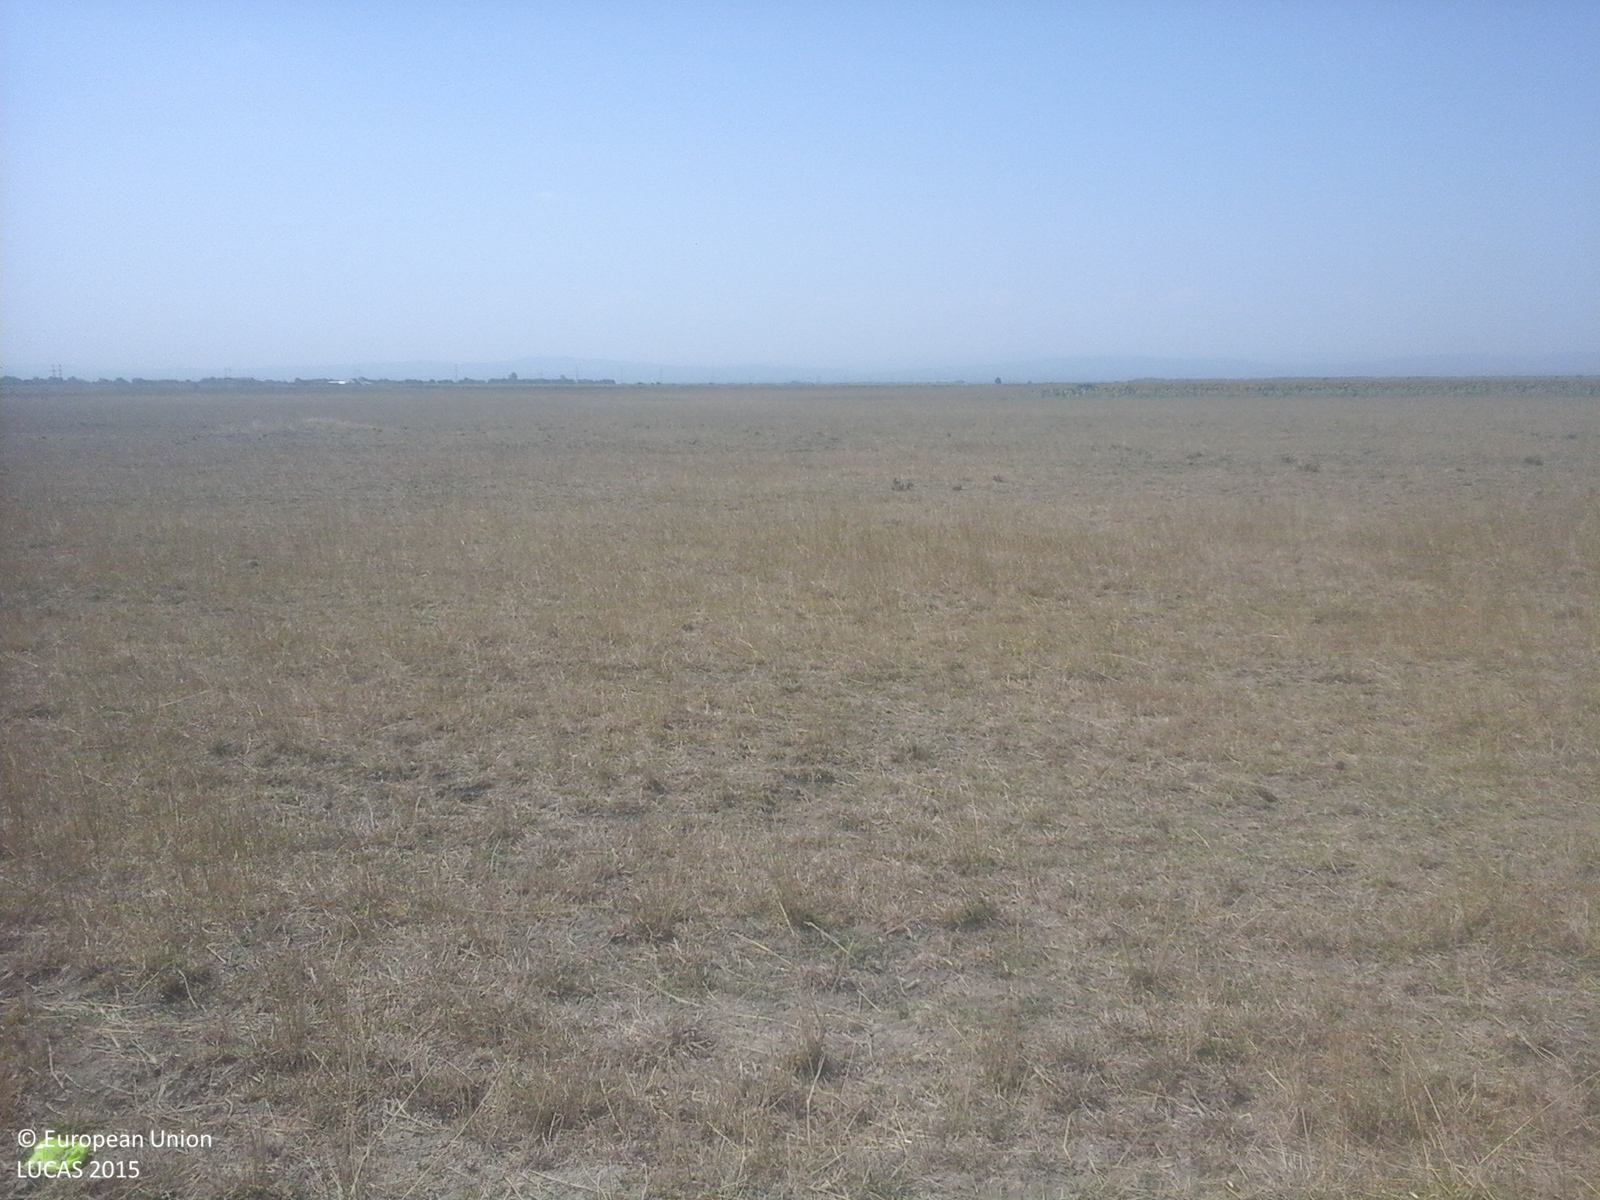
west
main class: Grassland
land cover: Grassland without tree/shrub cover
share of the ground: > 75 %
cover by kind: herbaceous plants 100 %
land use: Agriculture (excluding fallow land and kitchen gardens)
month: August
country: RO
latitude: 45.5667
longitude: 27.3311
